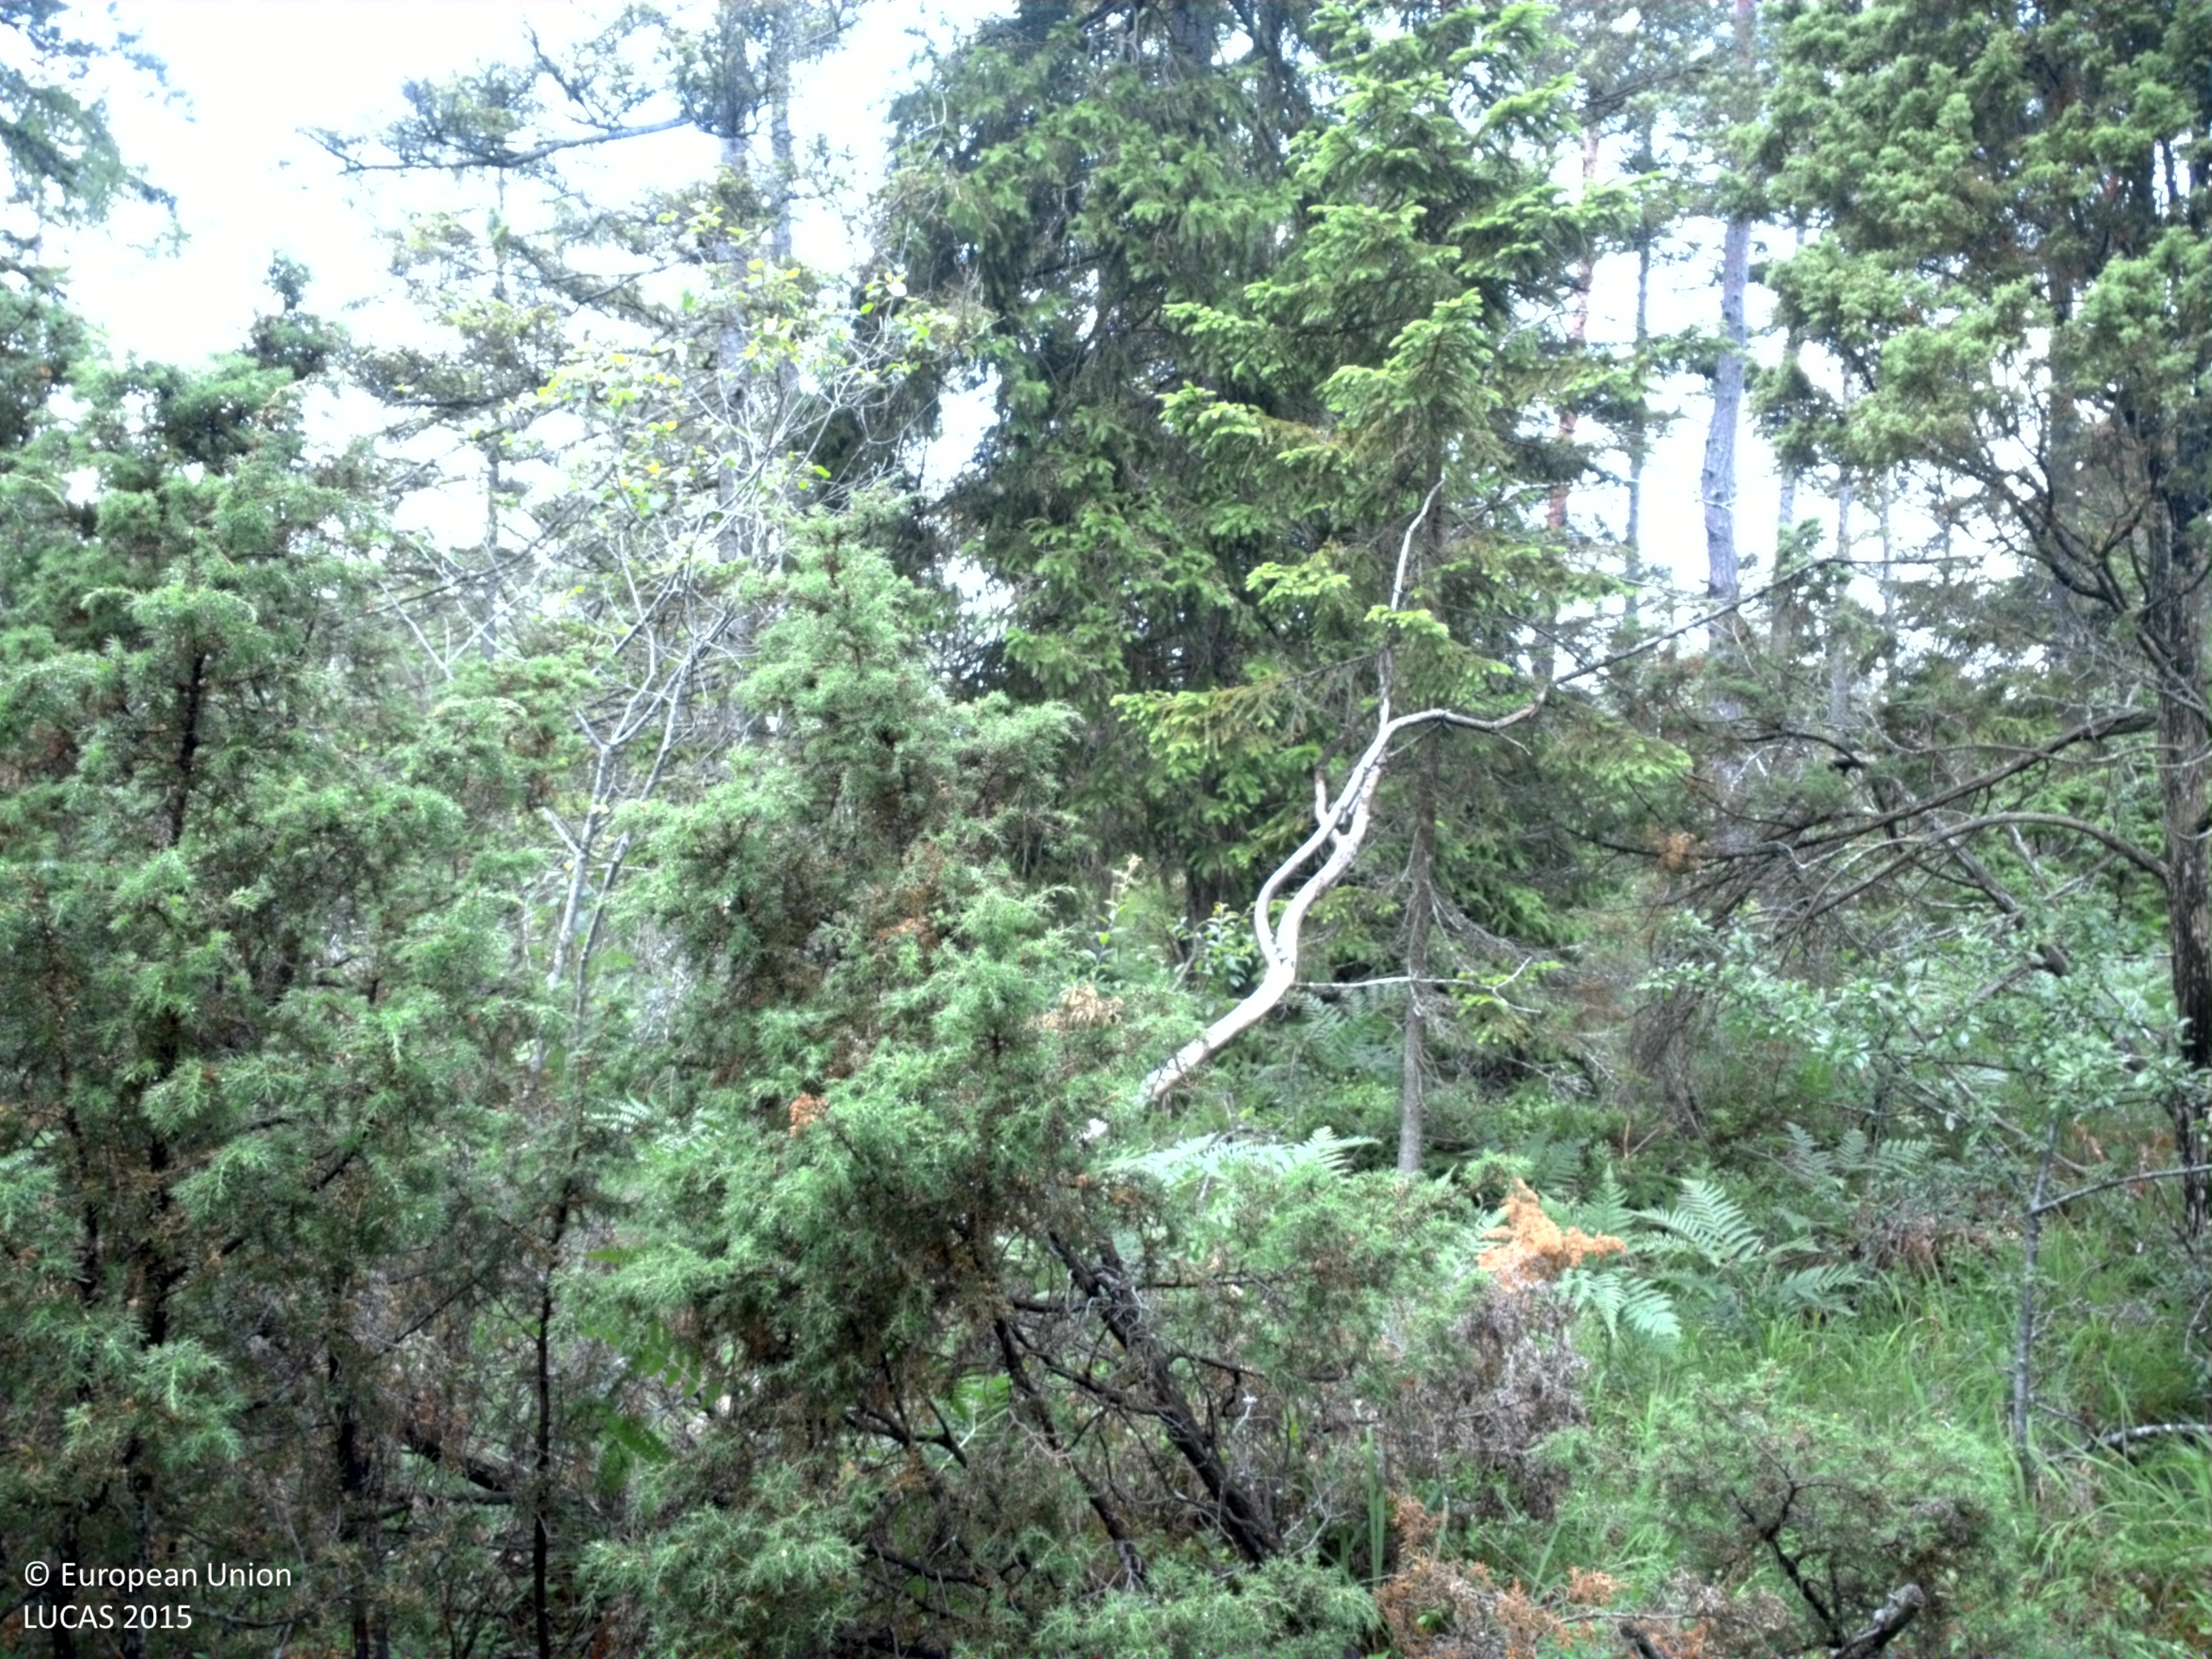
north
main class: Woodland
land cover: Other mixed woodland
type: hemiboreal forest and nemoral coniferous forest and mixed broadleaved-coniferous forest
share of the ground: 50 - 75 %
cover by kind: coniferous forest trees 50 %, broadleaved forest trees 20 %, shrubs 15 %, herbaceous plants 15 %
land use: Forestry
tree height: > 5 m
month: July
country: SE
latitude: 57.4088
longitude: 18.7497
